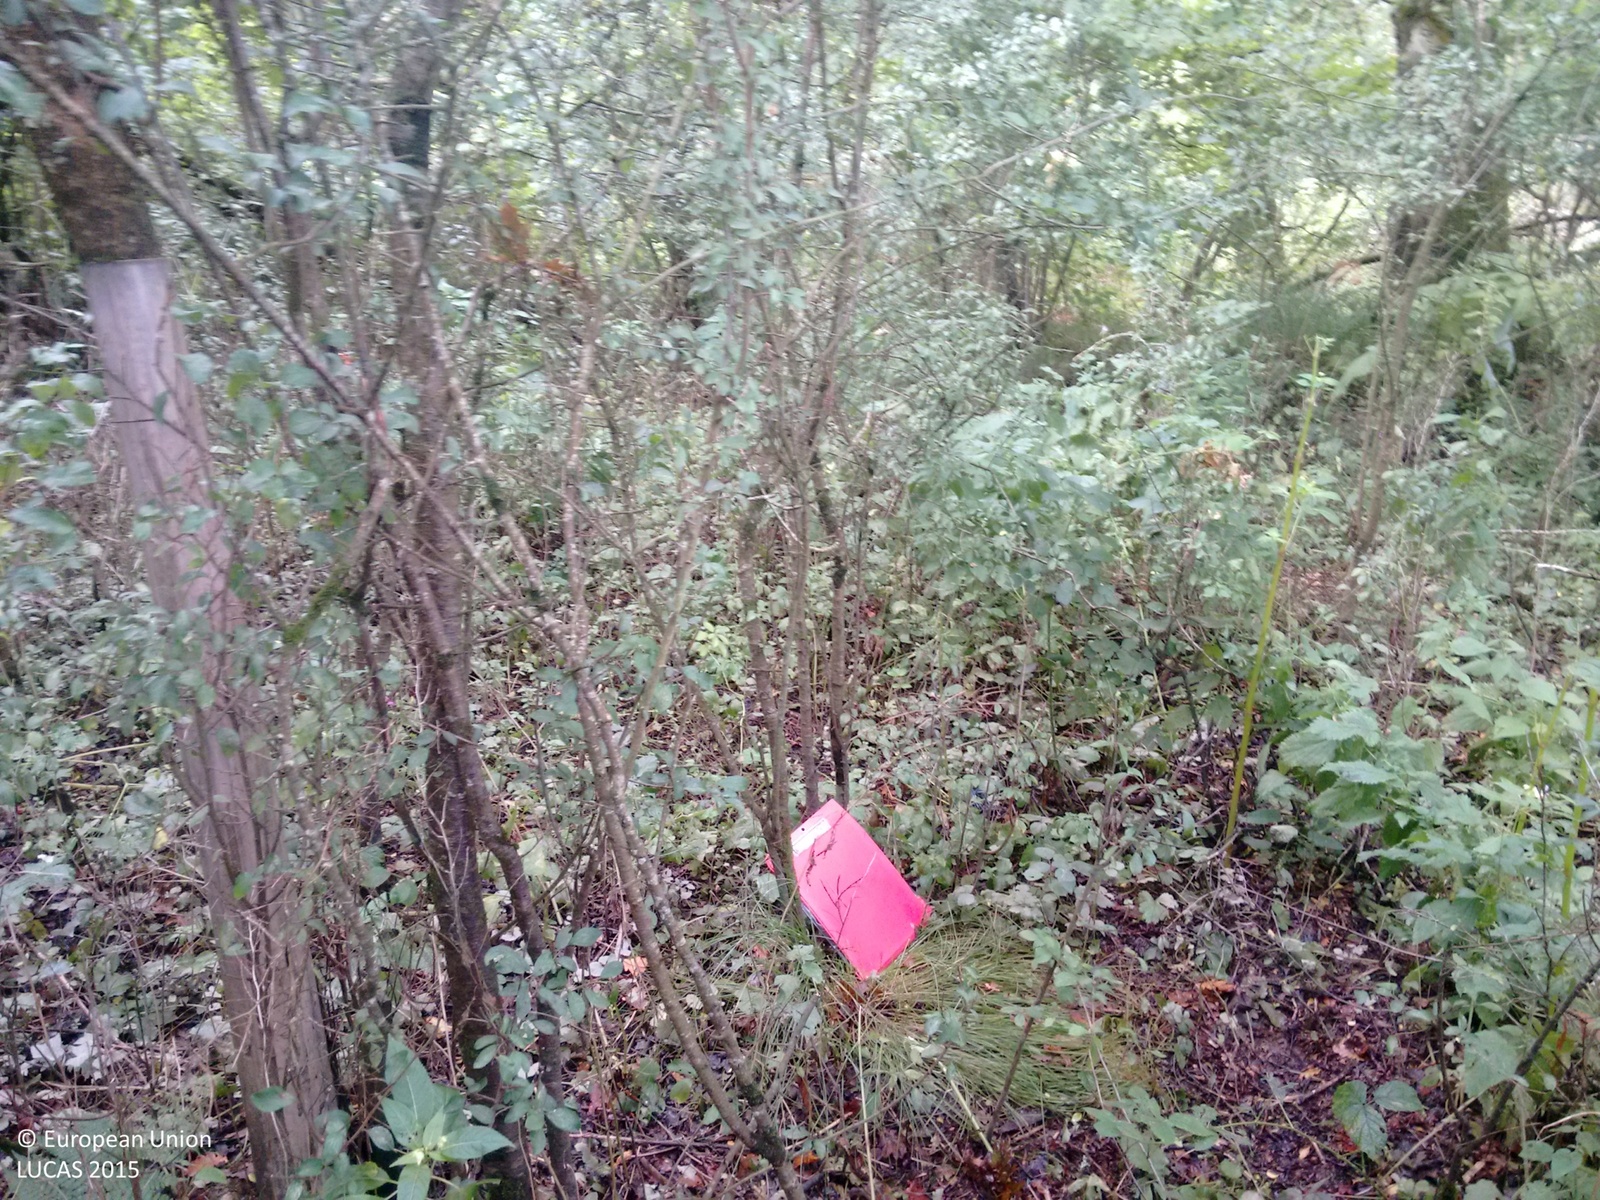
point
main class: Woodland
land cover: Broadleaved woodland
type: mesophytic deciduous forest
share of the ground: > 75 %
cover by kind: broadleaved forest trees 100 %
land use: Semi-natural and natural areas not in use
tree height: > 5 m
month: September
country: GB
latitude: 50.7613
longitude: -4.4072
